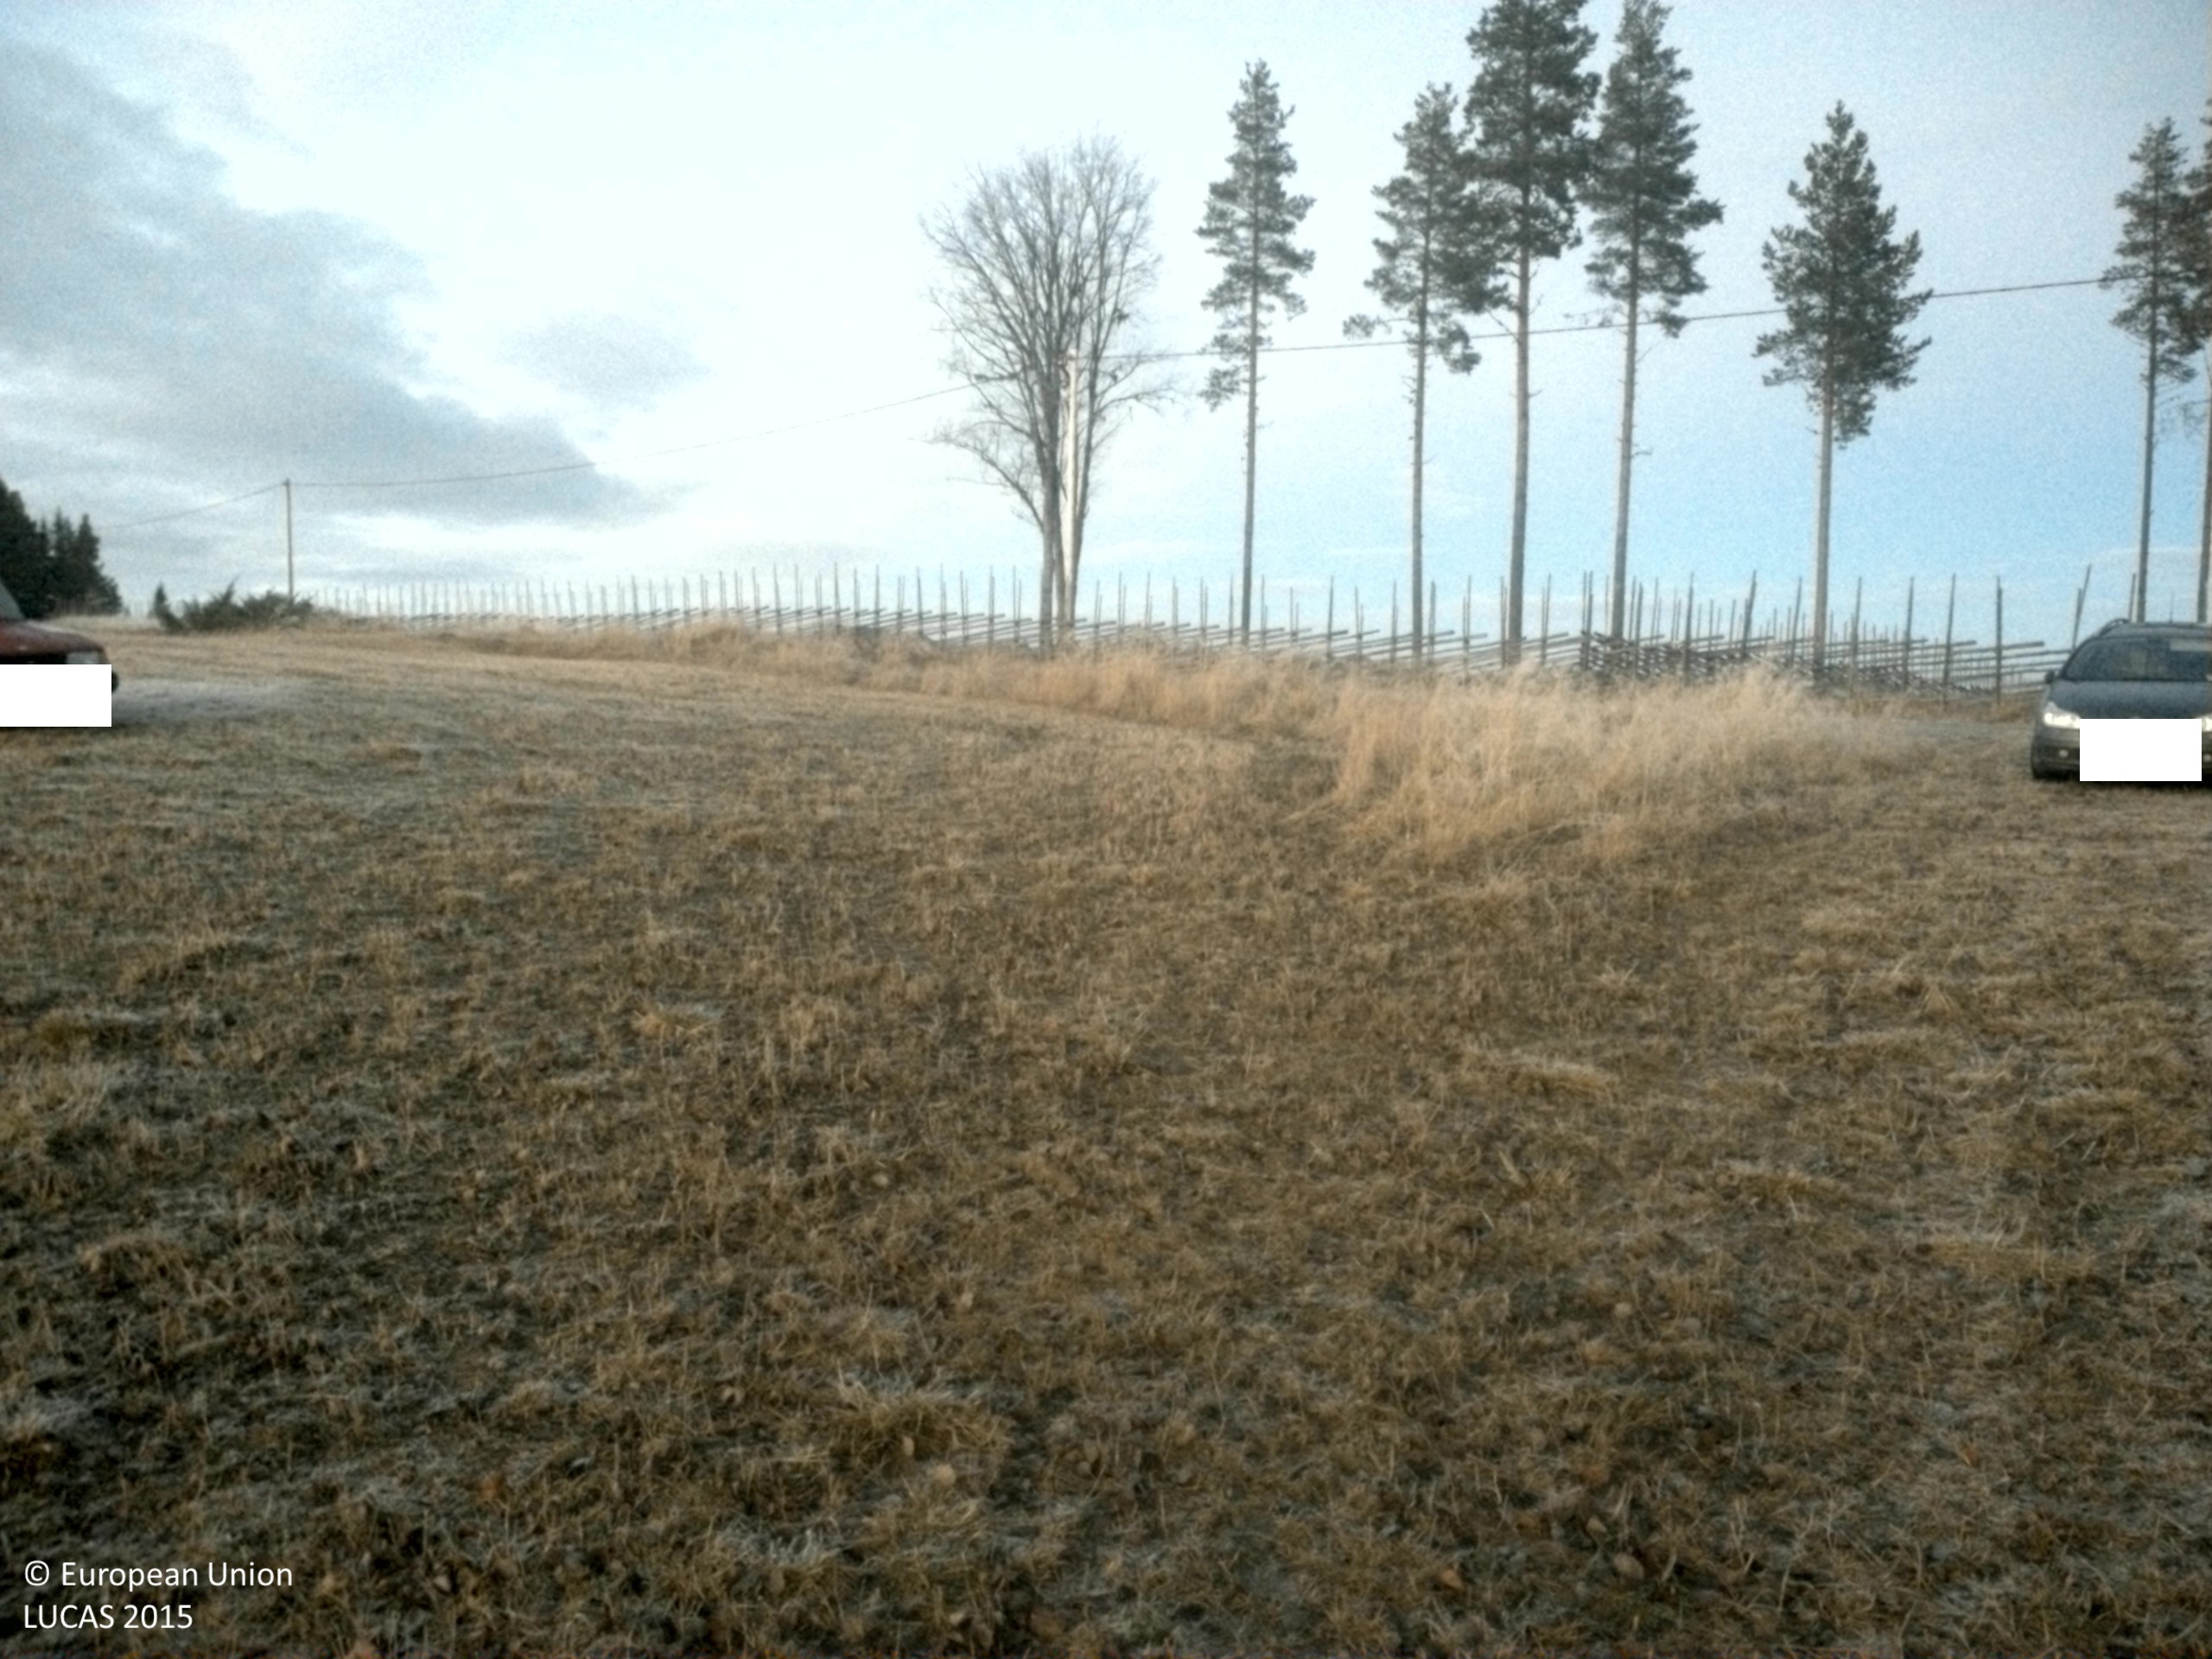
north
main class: Cropland
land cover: Mixed cereals for fodder
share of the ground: > 75 %
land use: Agriculture (excluding fallow land and kitchen gardens)
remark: Harvested field
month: November
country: SE
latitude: 63.7987
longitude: 15.9207
